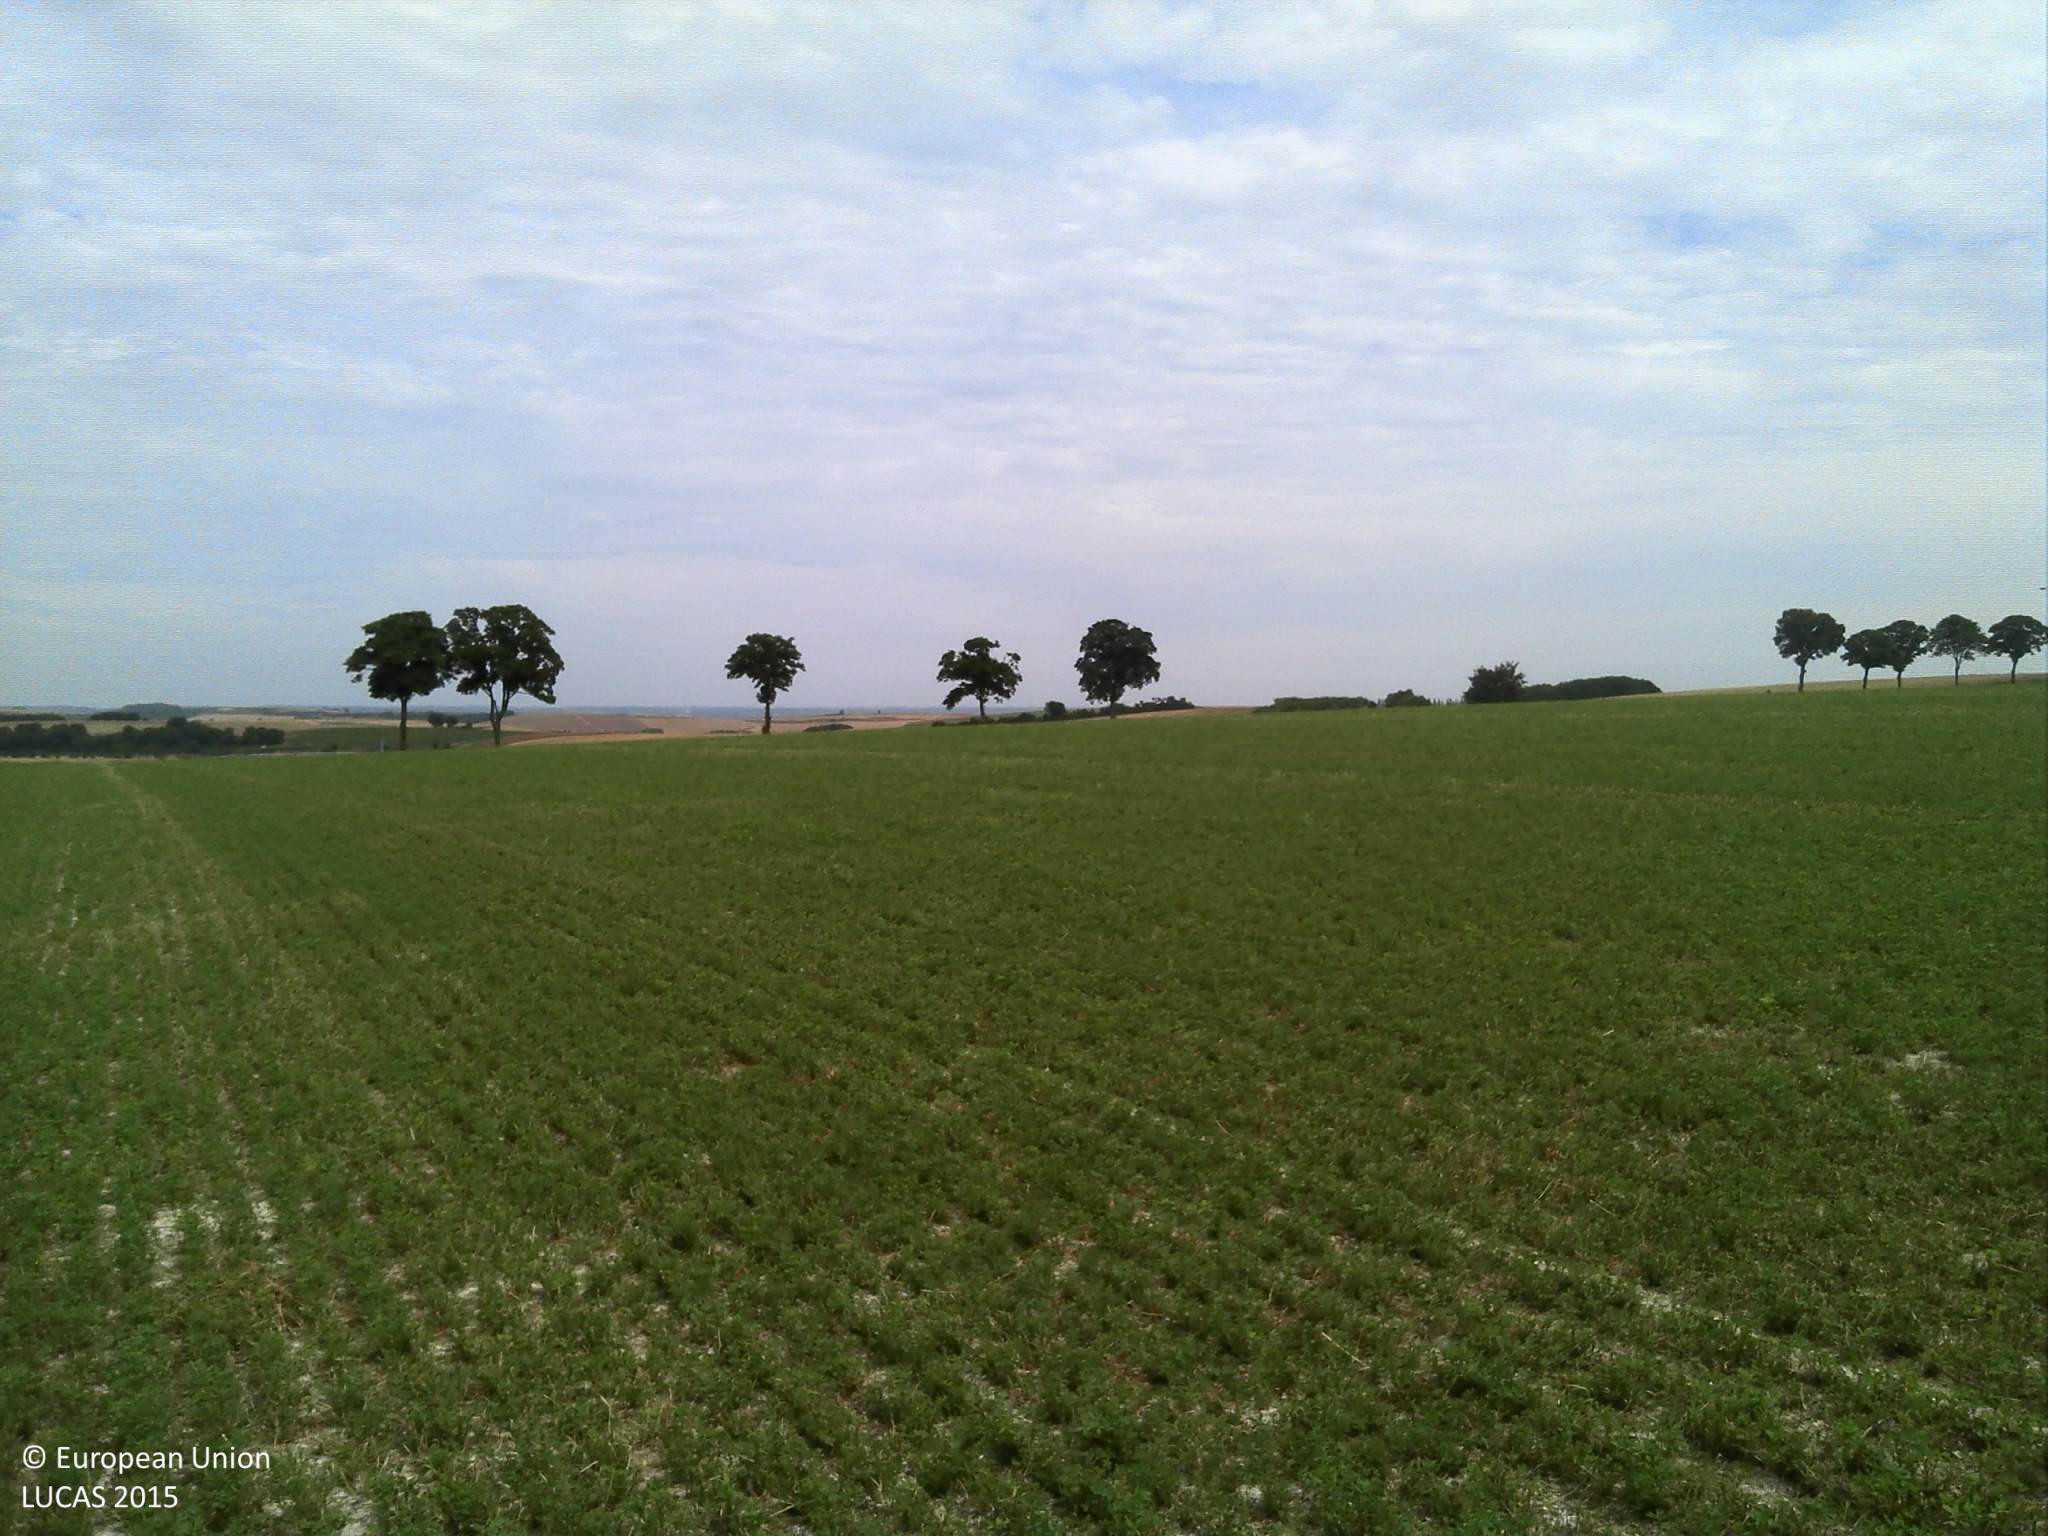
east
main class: Cropland
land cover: Lucerne
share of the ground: > 75 %
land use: Agriculture (excluding fallow land and kitchen gardens)
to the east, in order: Lucerne; Ditches and canals; Grass margins; Paved roads, cycling and walking lanes; Fences; Grassland without tree/shrub cover; Ditches and canals; Grass margins; Tracks; Rape and turnip rape
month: July
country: FR
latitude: 49.5707
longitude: 4.2569
